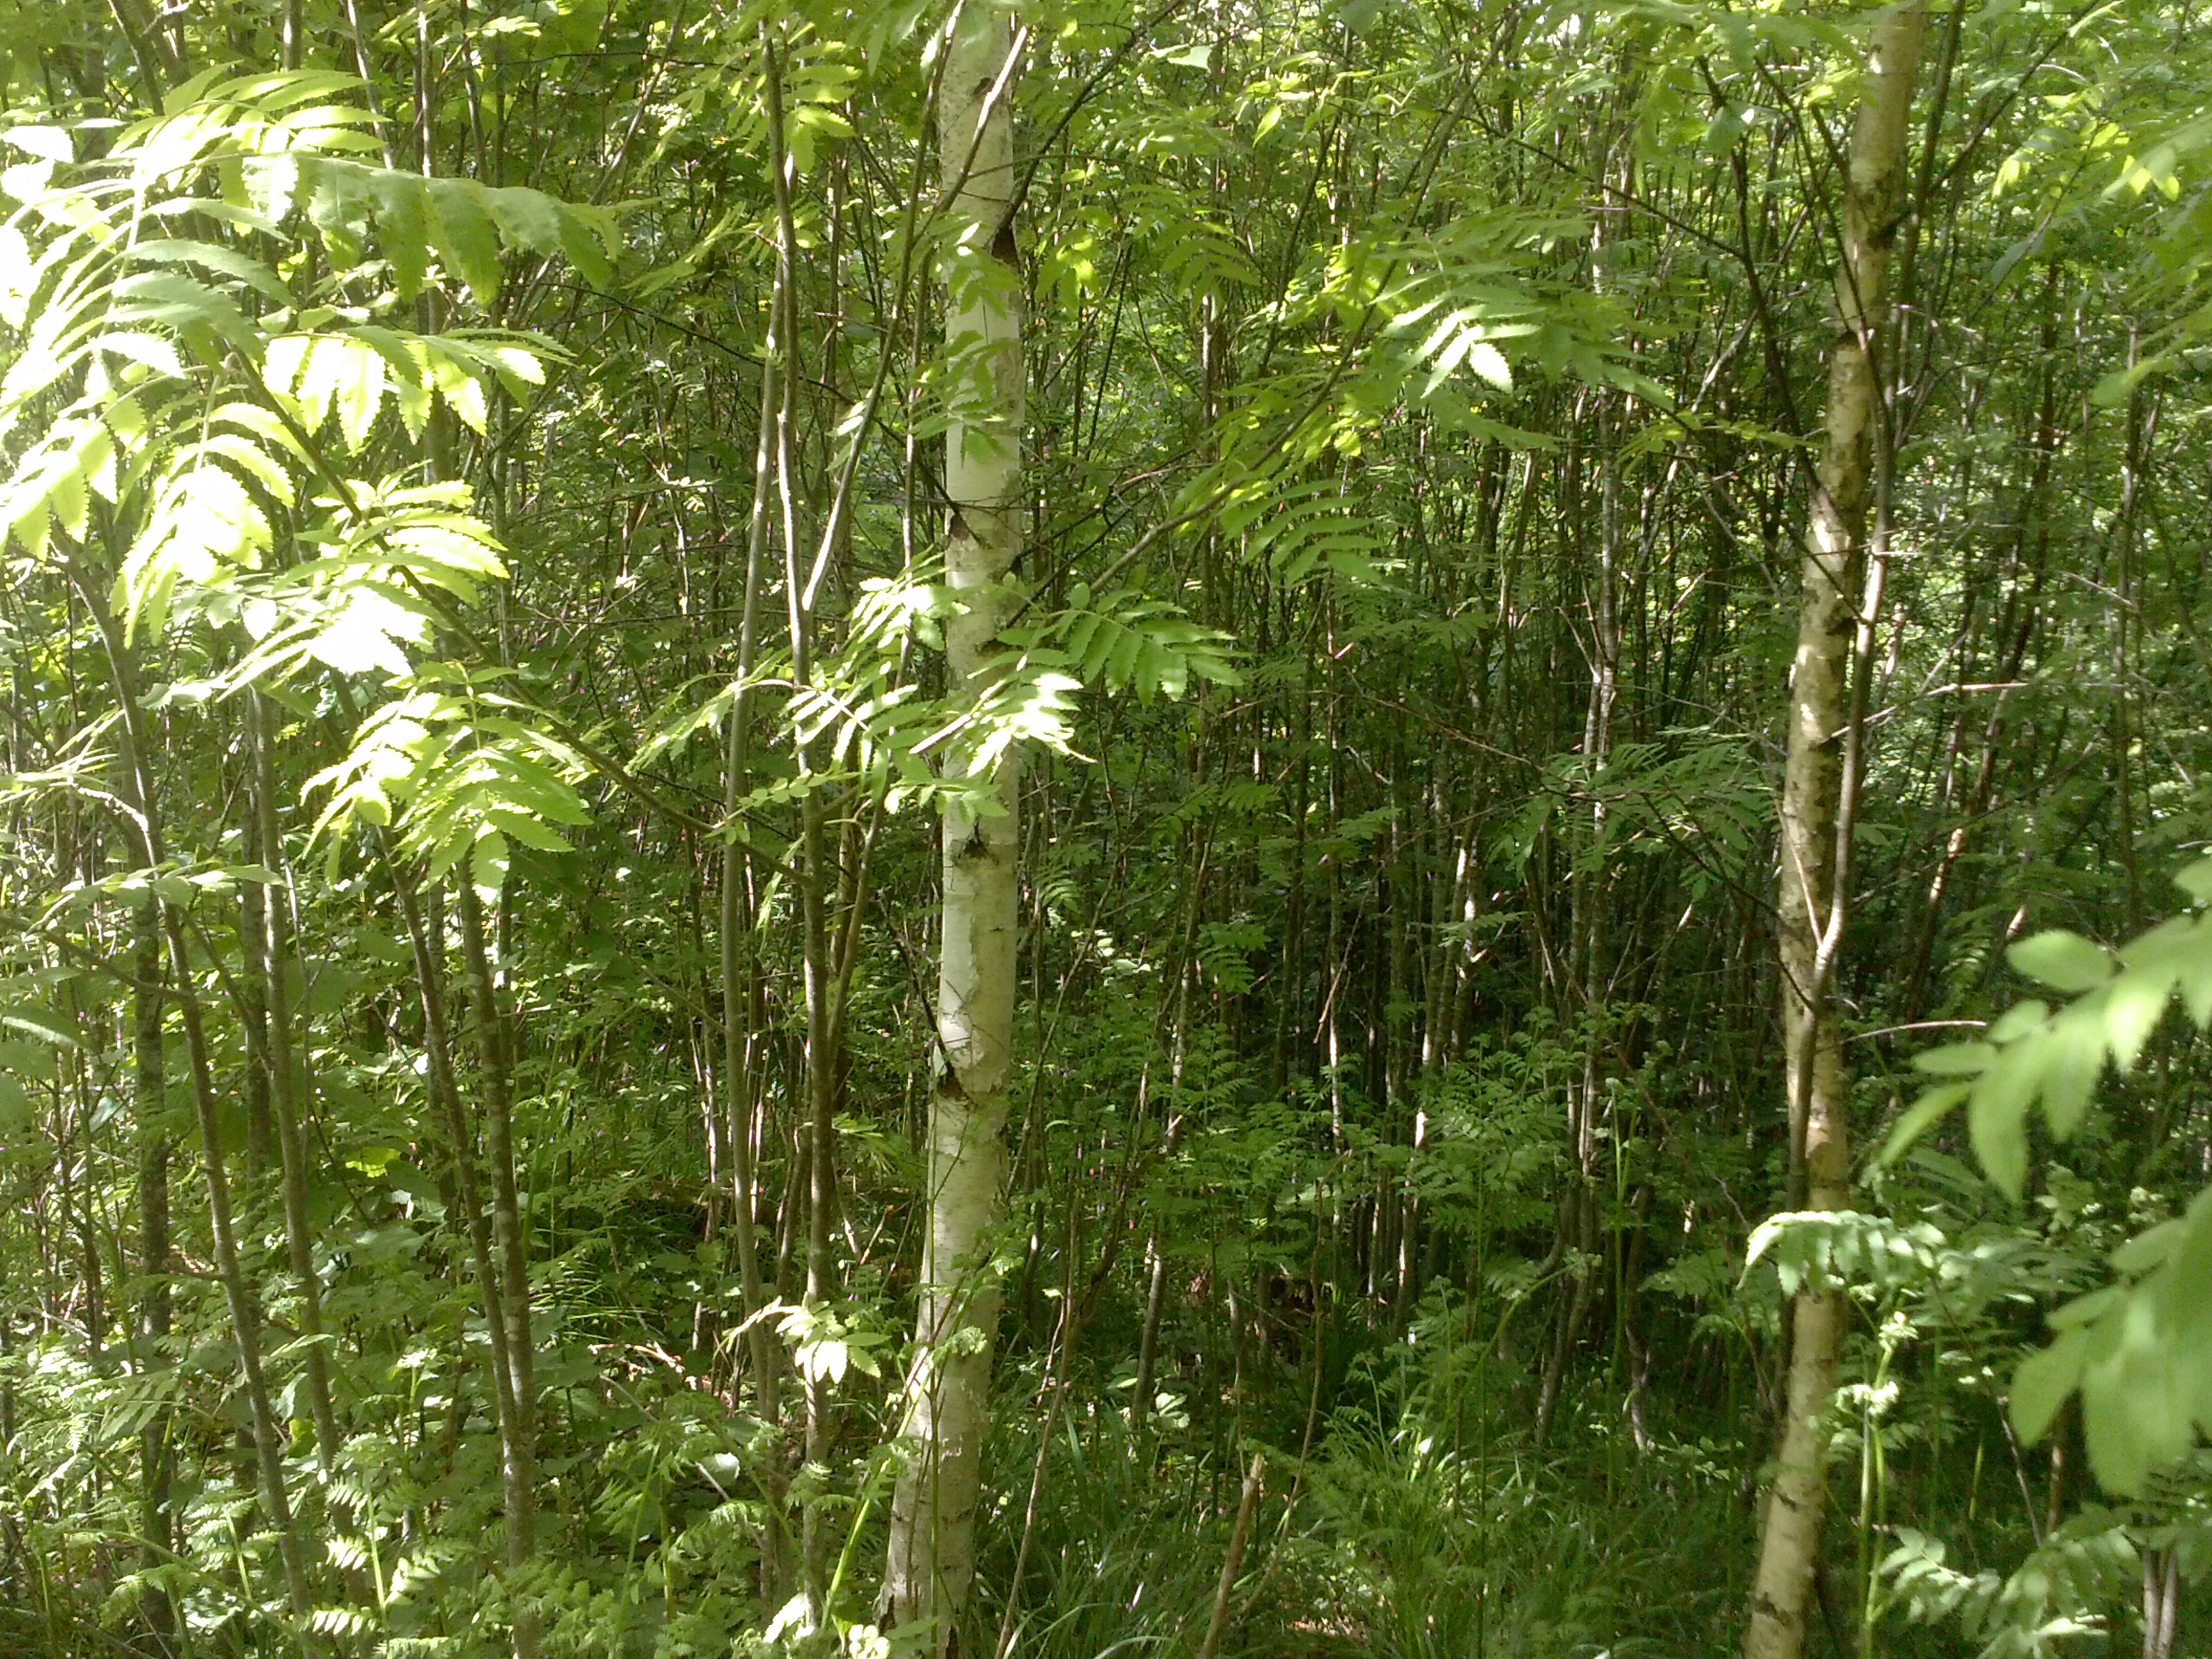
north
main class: Woodland
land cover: Broadleaved woodland
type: non-riverine alder, birch or aspen forest
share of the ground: > 75 %
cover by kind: broadleaved forest trees 100 %
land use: Forestry
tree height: > 5 m
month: June
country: LV
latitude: 56.4052
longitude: 27.4023
